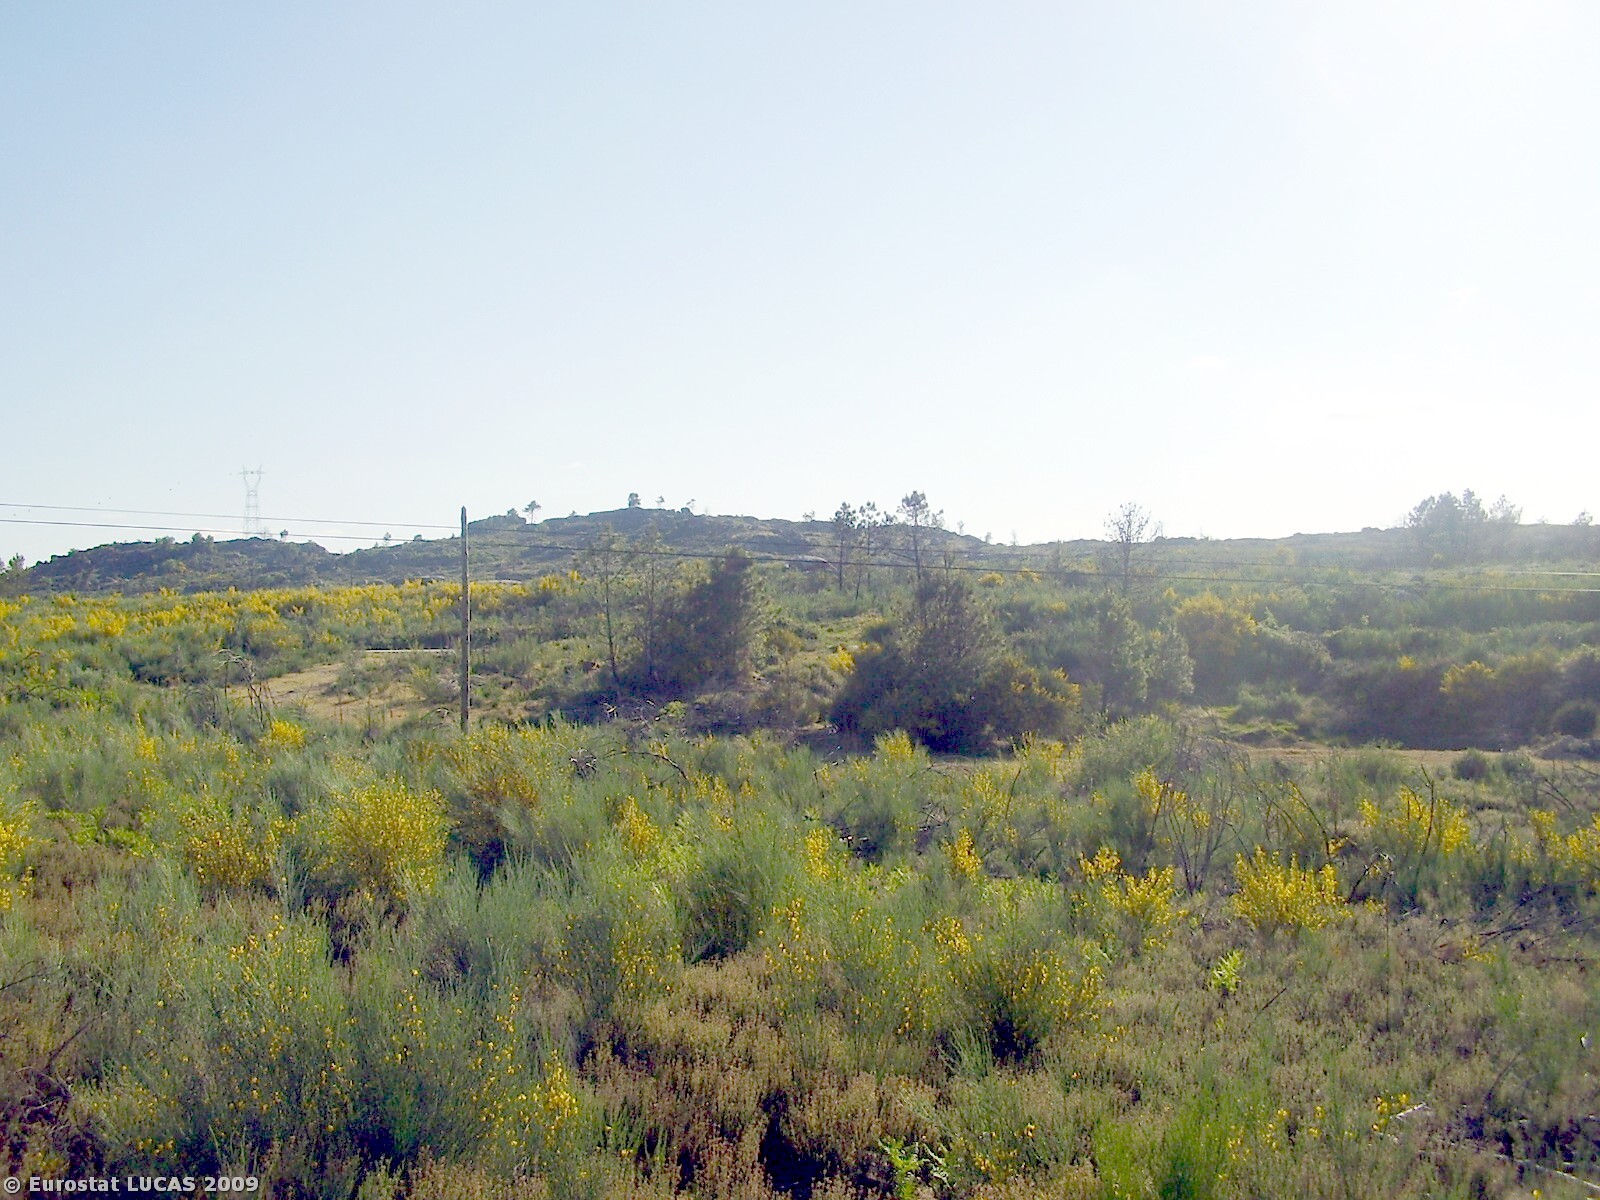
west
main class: Shrubland
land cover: Shrubland without tree cover
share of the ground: > 75 %
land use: Unused
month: May
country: PT
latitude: 41.2542
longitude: -7.2427
